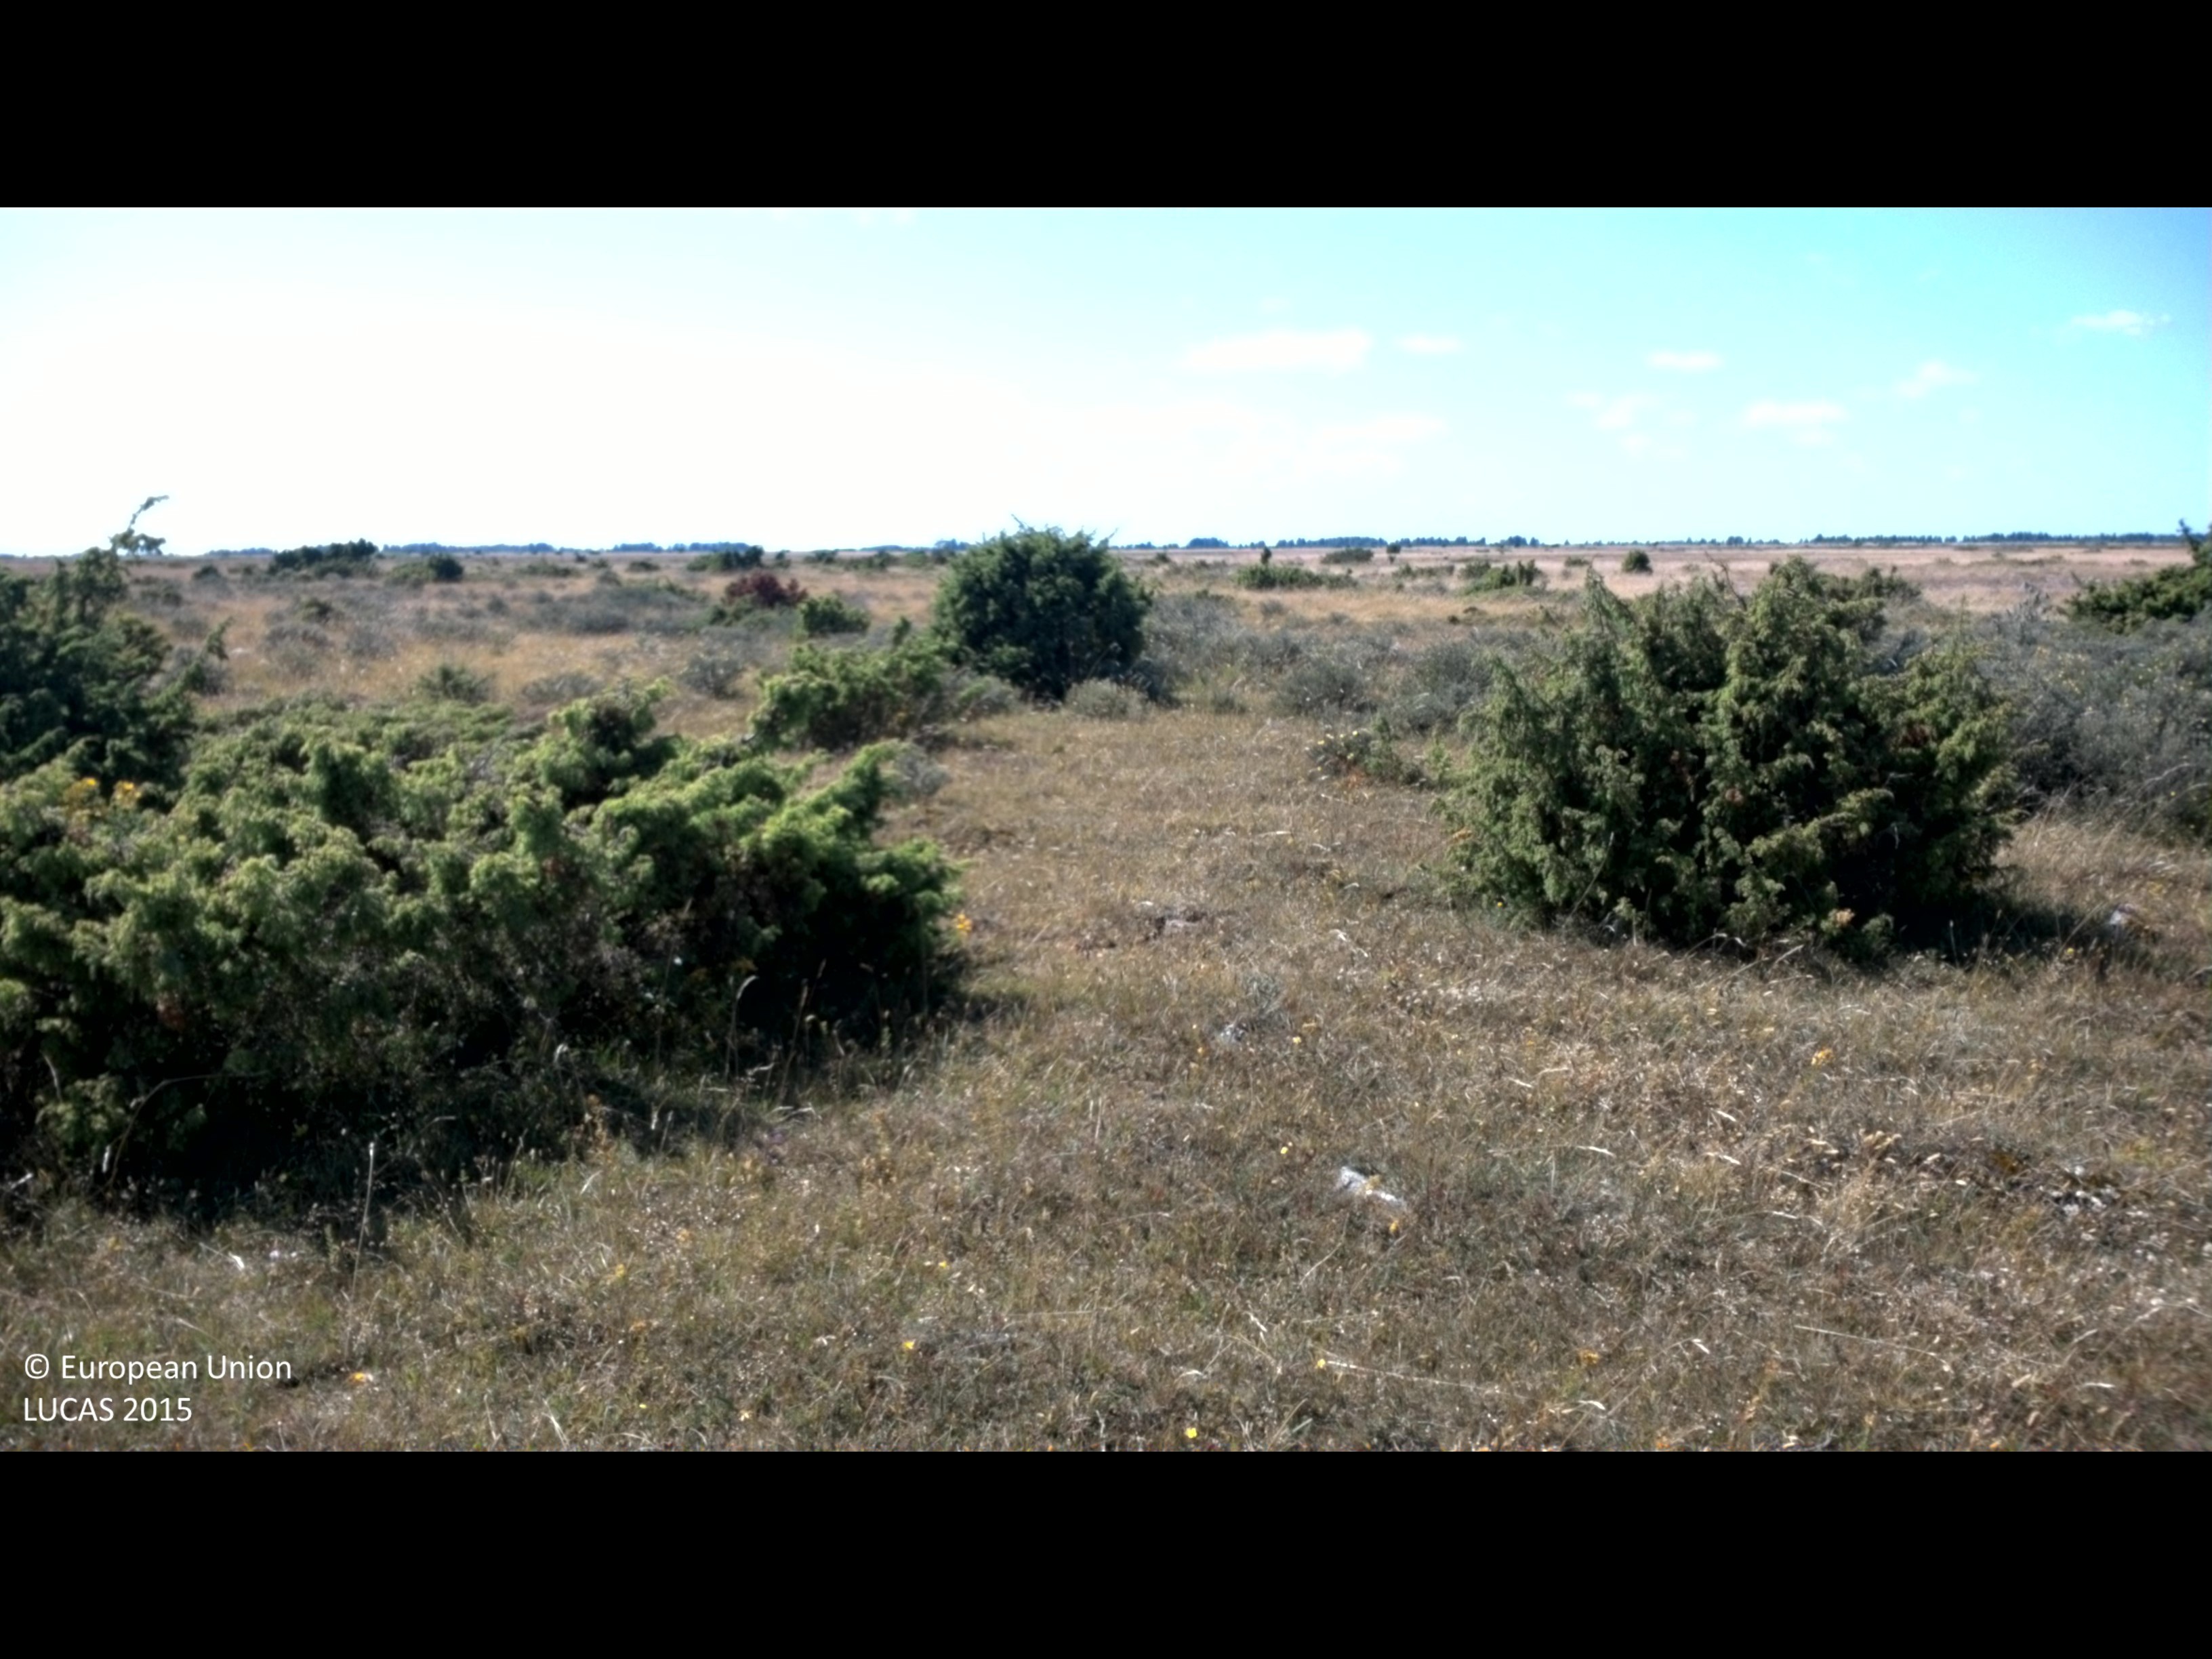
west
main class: Grassland
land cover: Grassland without tree/shrub cover
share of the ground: > 75 %
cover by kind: herbaceous plants 95 %, shrubs 5 %
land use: Agriculture (excluding fallow land and kitchen gardens)
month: July
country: SE
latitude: 56.4003
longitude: 16.5319
